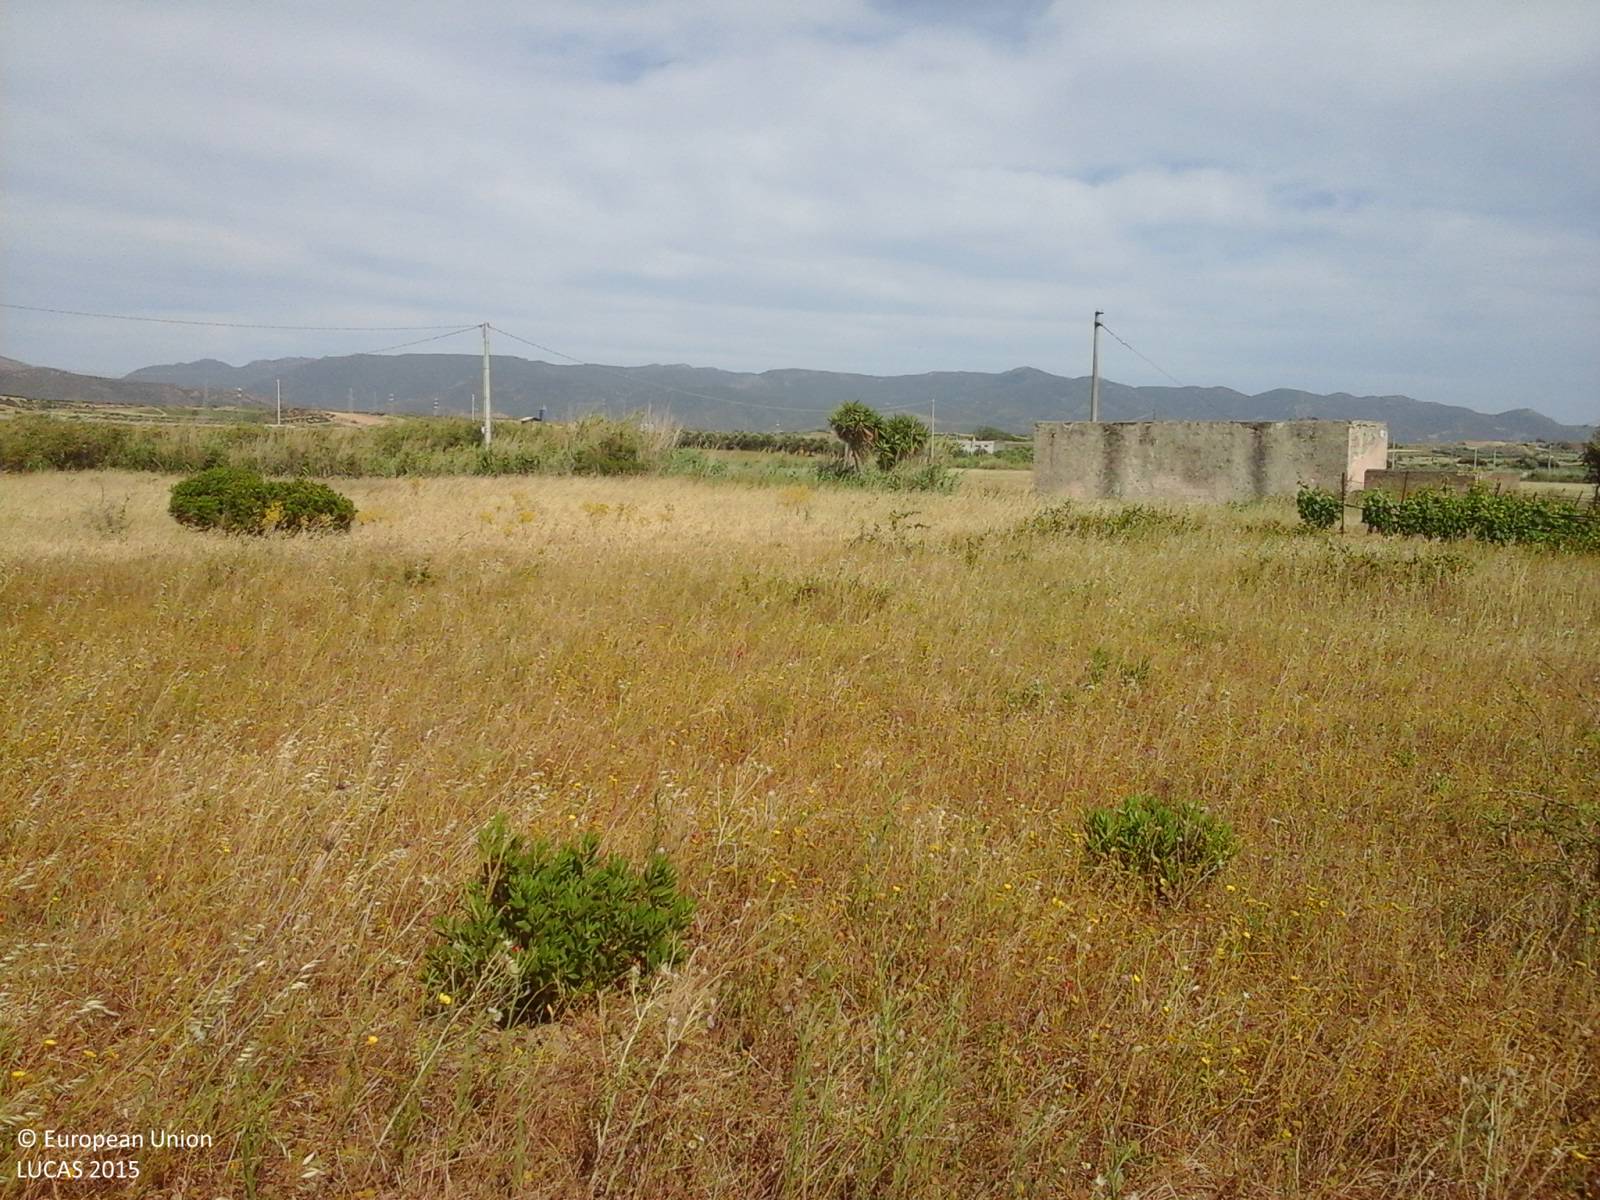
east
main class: Grassland
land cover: Spontaneously vegetated surfaces
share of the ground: > 75 %
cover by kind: herbaceous plants 100 %
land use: Fallow land
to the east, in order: Spontaneously vegetated surfaces; Tracks; Spontaneously vegetated surfaces; Abandoned hedges; Electric lines; Other fresh vegetables; Barley; Other non-permanent industrial crops; Shruby margins; Ditches and canals; Shruby margins; Other non-permanent industrial crops; Tracks; Fences; Oats
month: May
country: IT
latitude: 39.2681
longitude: 9.2282
